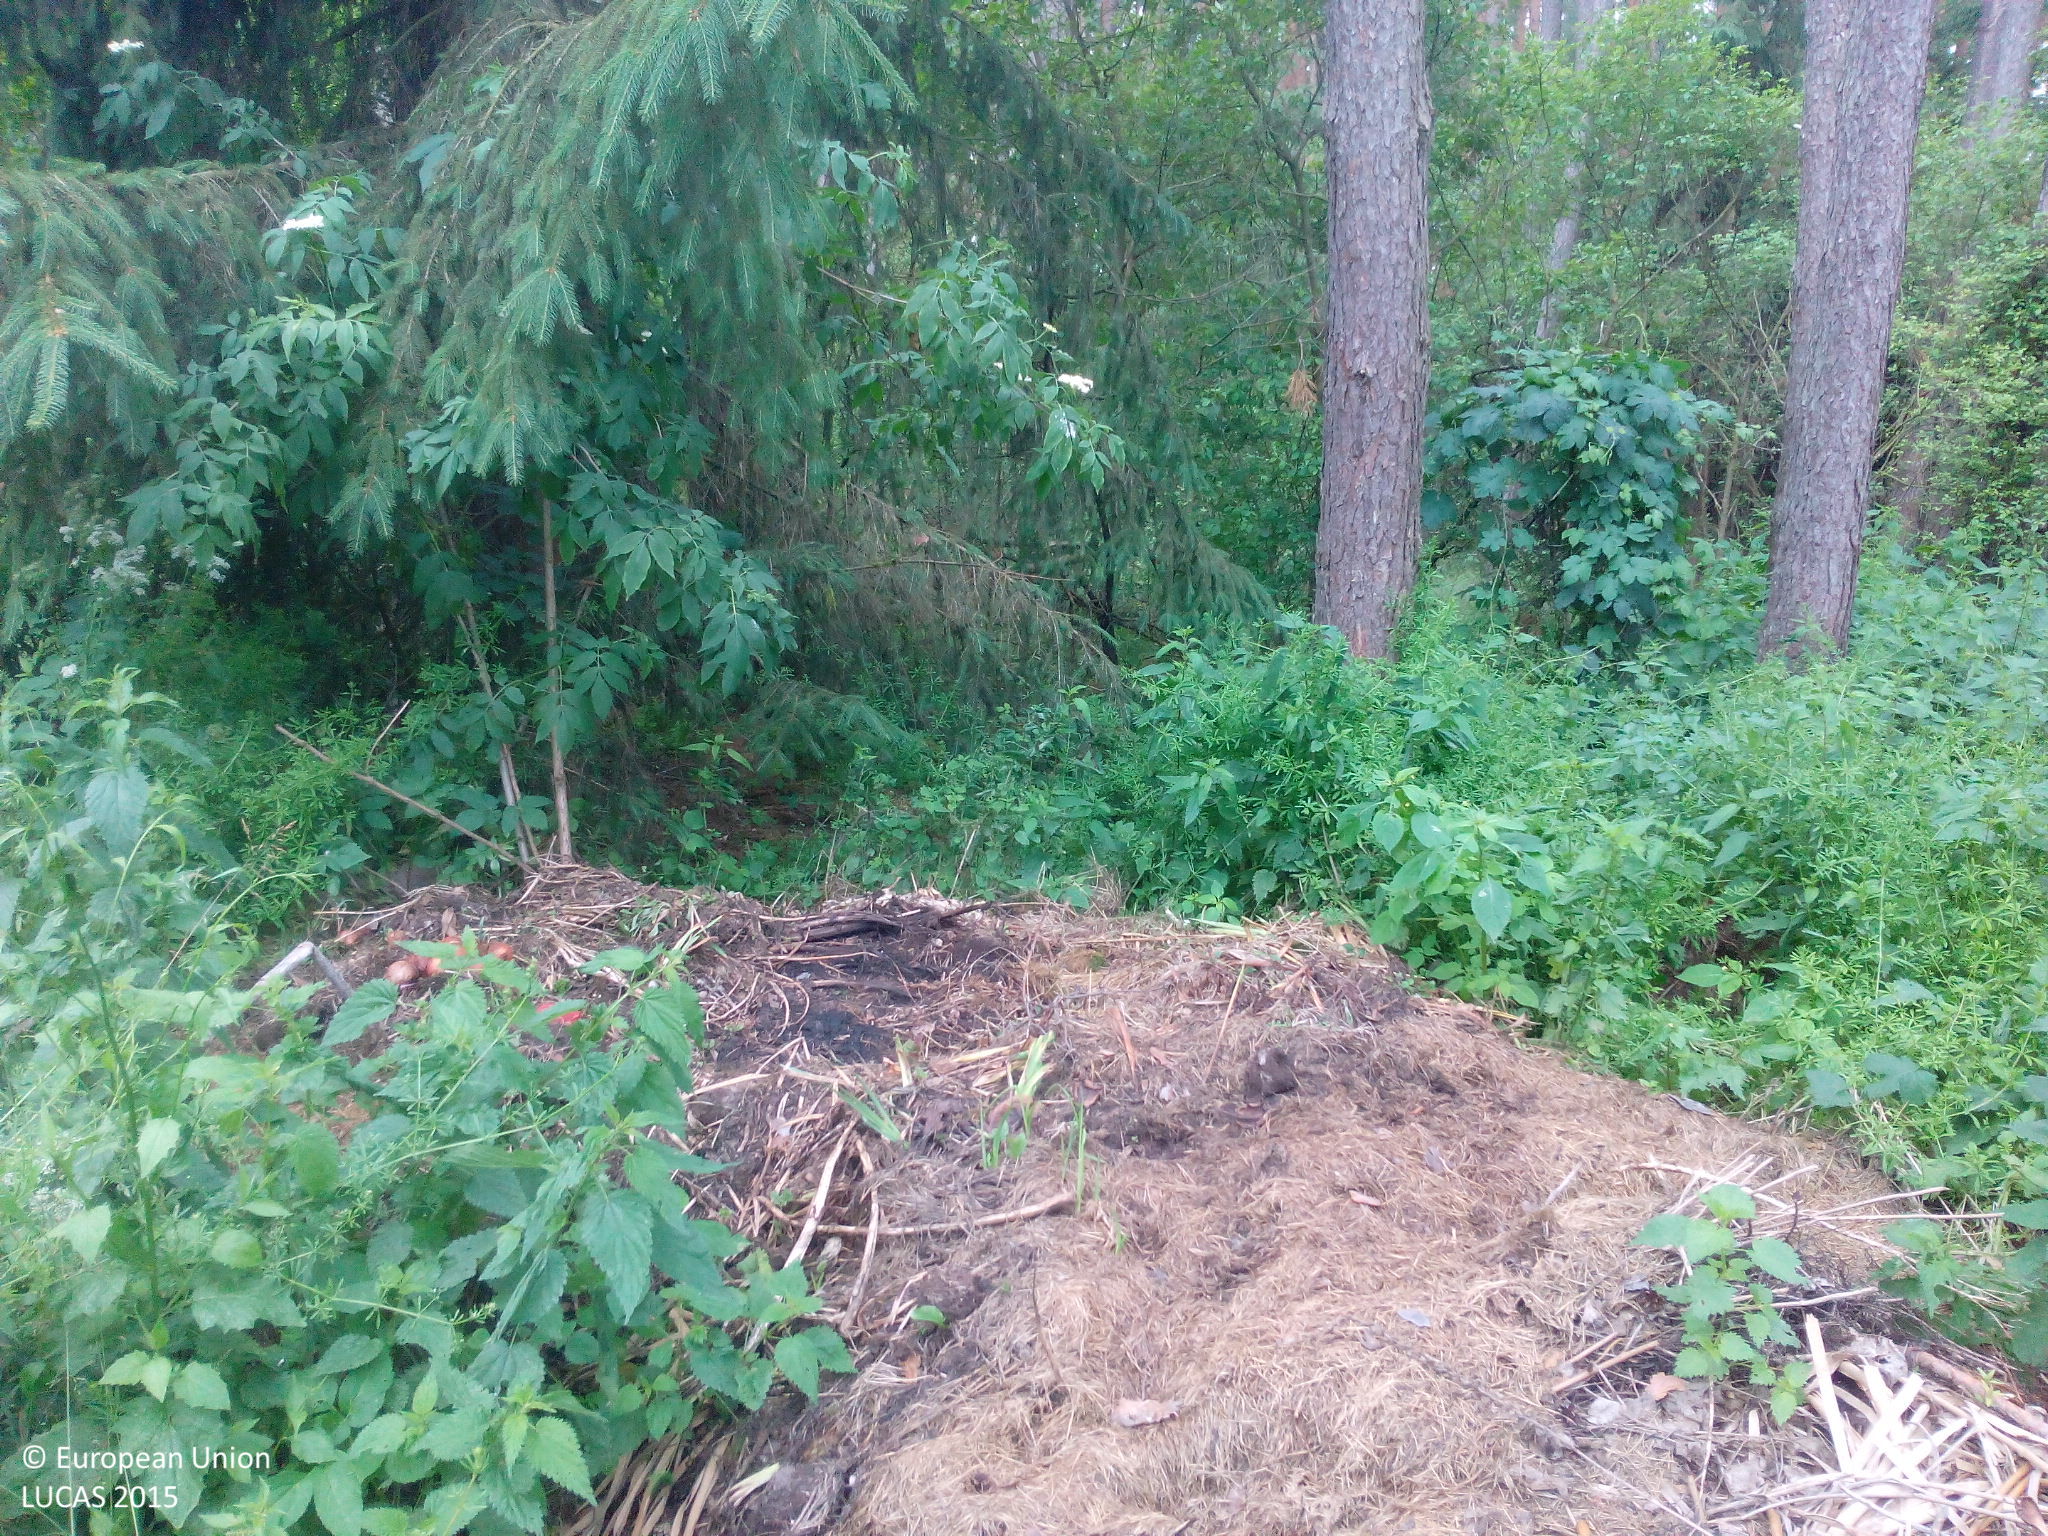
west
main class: Woodland
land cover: Pine dominated coniferous woodland
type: hemiboreal forest and nemoral coniferous forest and mixed broadleaved-coniferous forest
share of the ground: 50 - 75 %
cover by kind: coniferous forest trees 70 %, herbaceous plants 20 %, shrubs 10 %
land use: Forestry
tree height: > 5 m
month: June
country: DE
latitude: 49.2093
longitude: 10.9193
